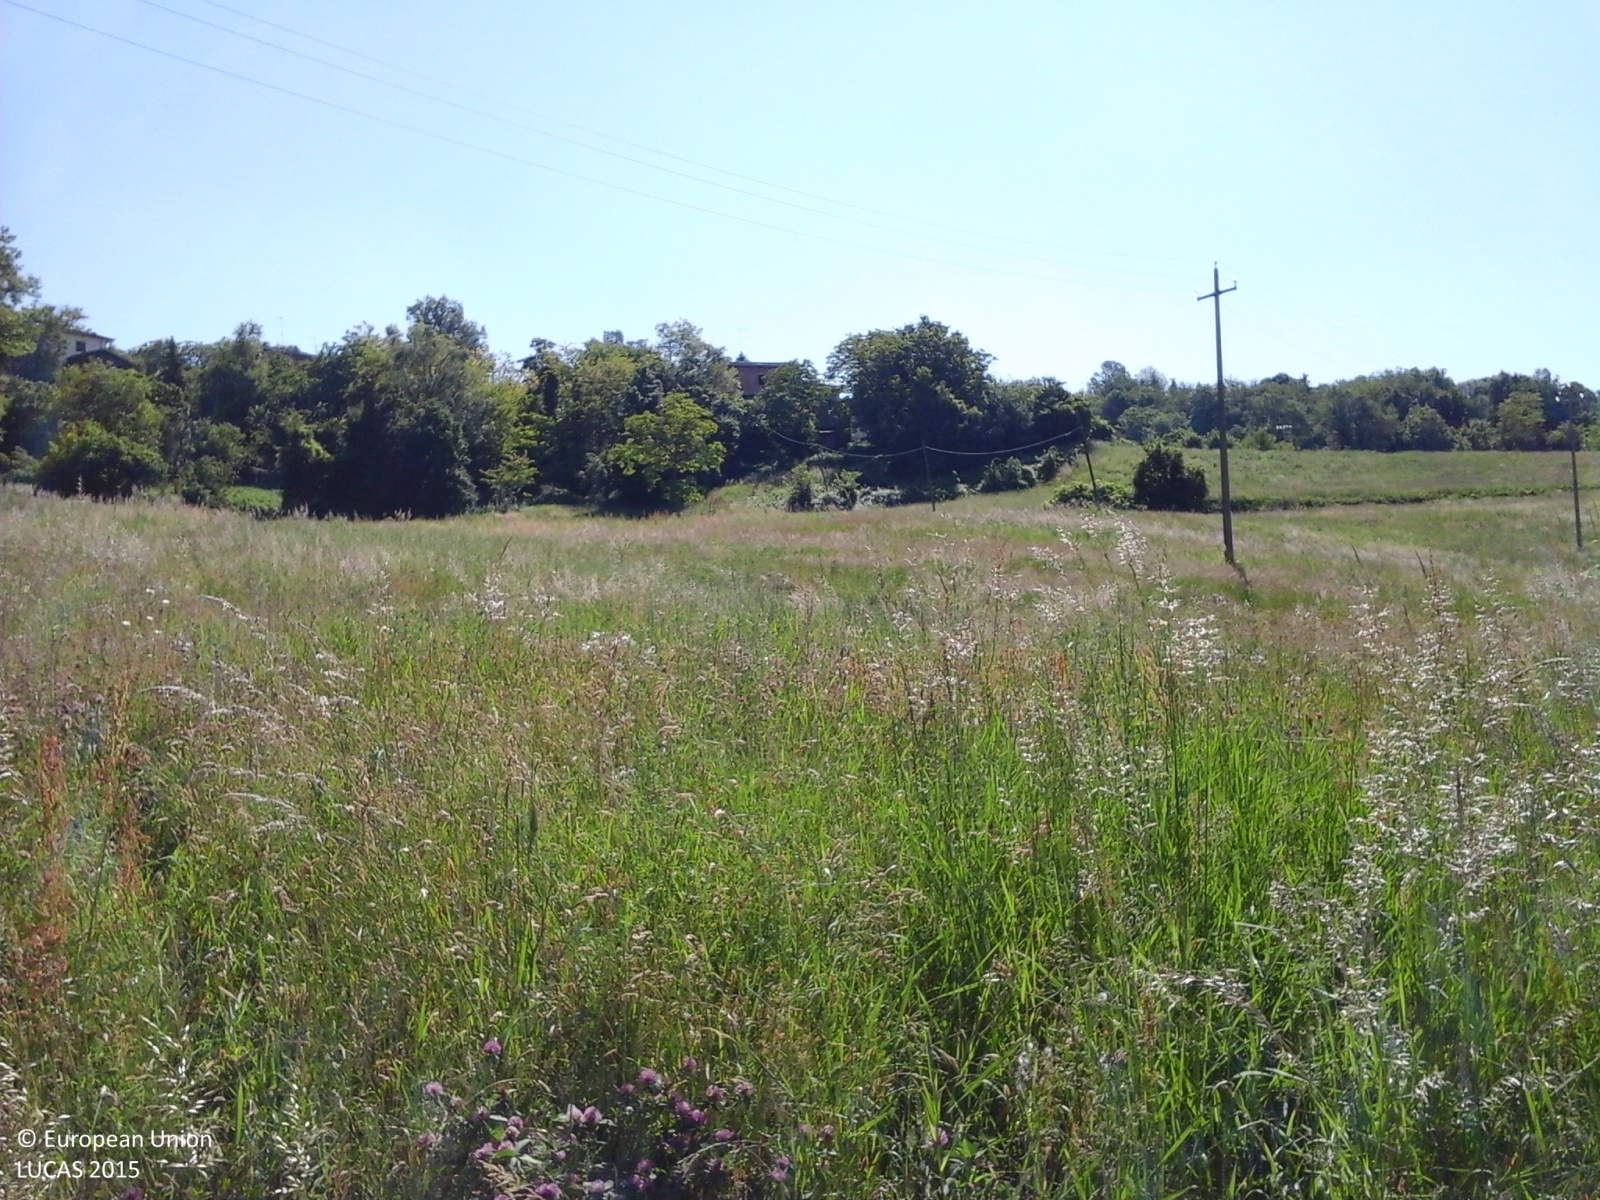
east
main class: Grassland
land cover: Grassland without tree/shrub cover
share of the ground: > 75 %
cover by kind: herbaceous plants 100 %
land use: Agriculture (excluding fallow land and kitchen gardens)
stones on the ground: < 10 %
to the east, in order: Grassland without tree/shrub cover; Electric lines; Grassland without tree/shrub cover; Single bushes/trees; Grassland without tree/shrub cover; Broadleaved woodland; Artificial constructions in urban areas; Grassland without tree/shrub cover; Single bushes/trees
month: May
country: IT
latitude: 44.3665
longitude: 10.6635
